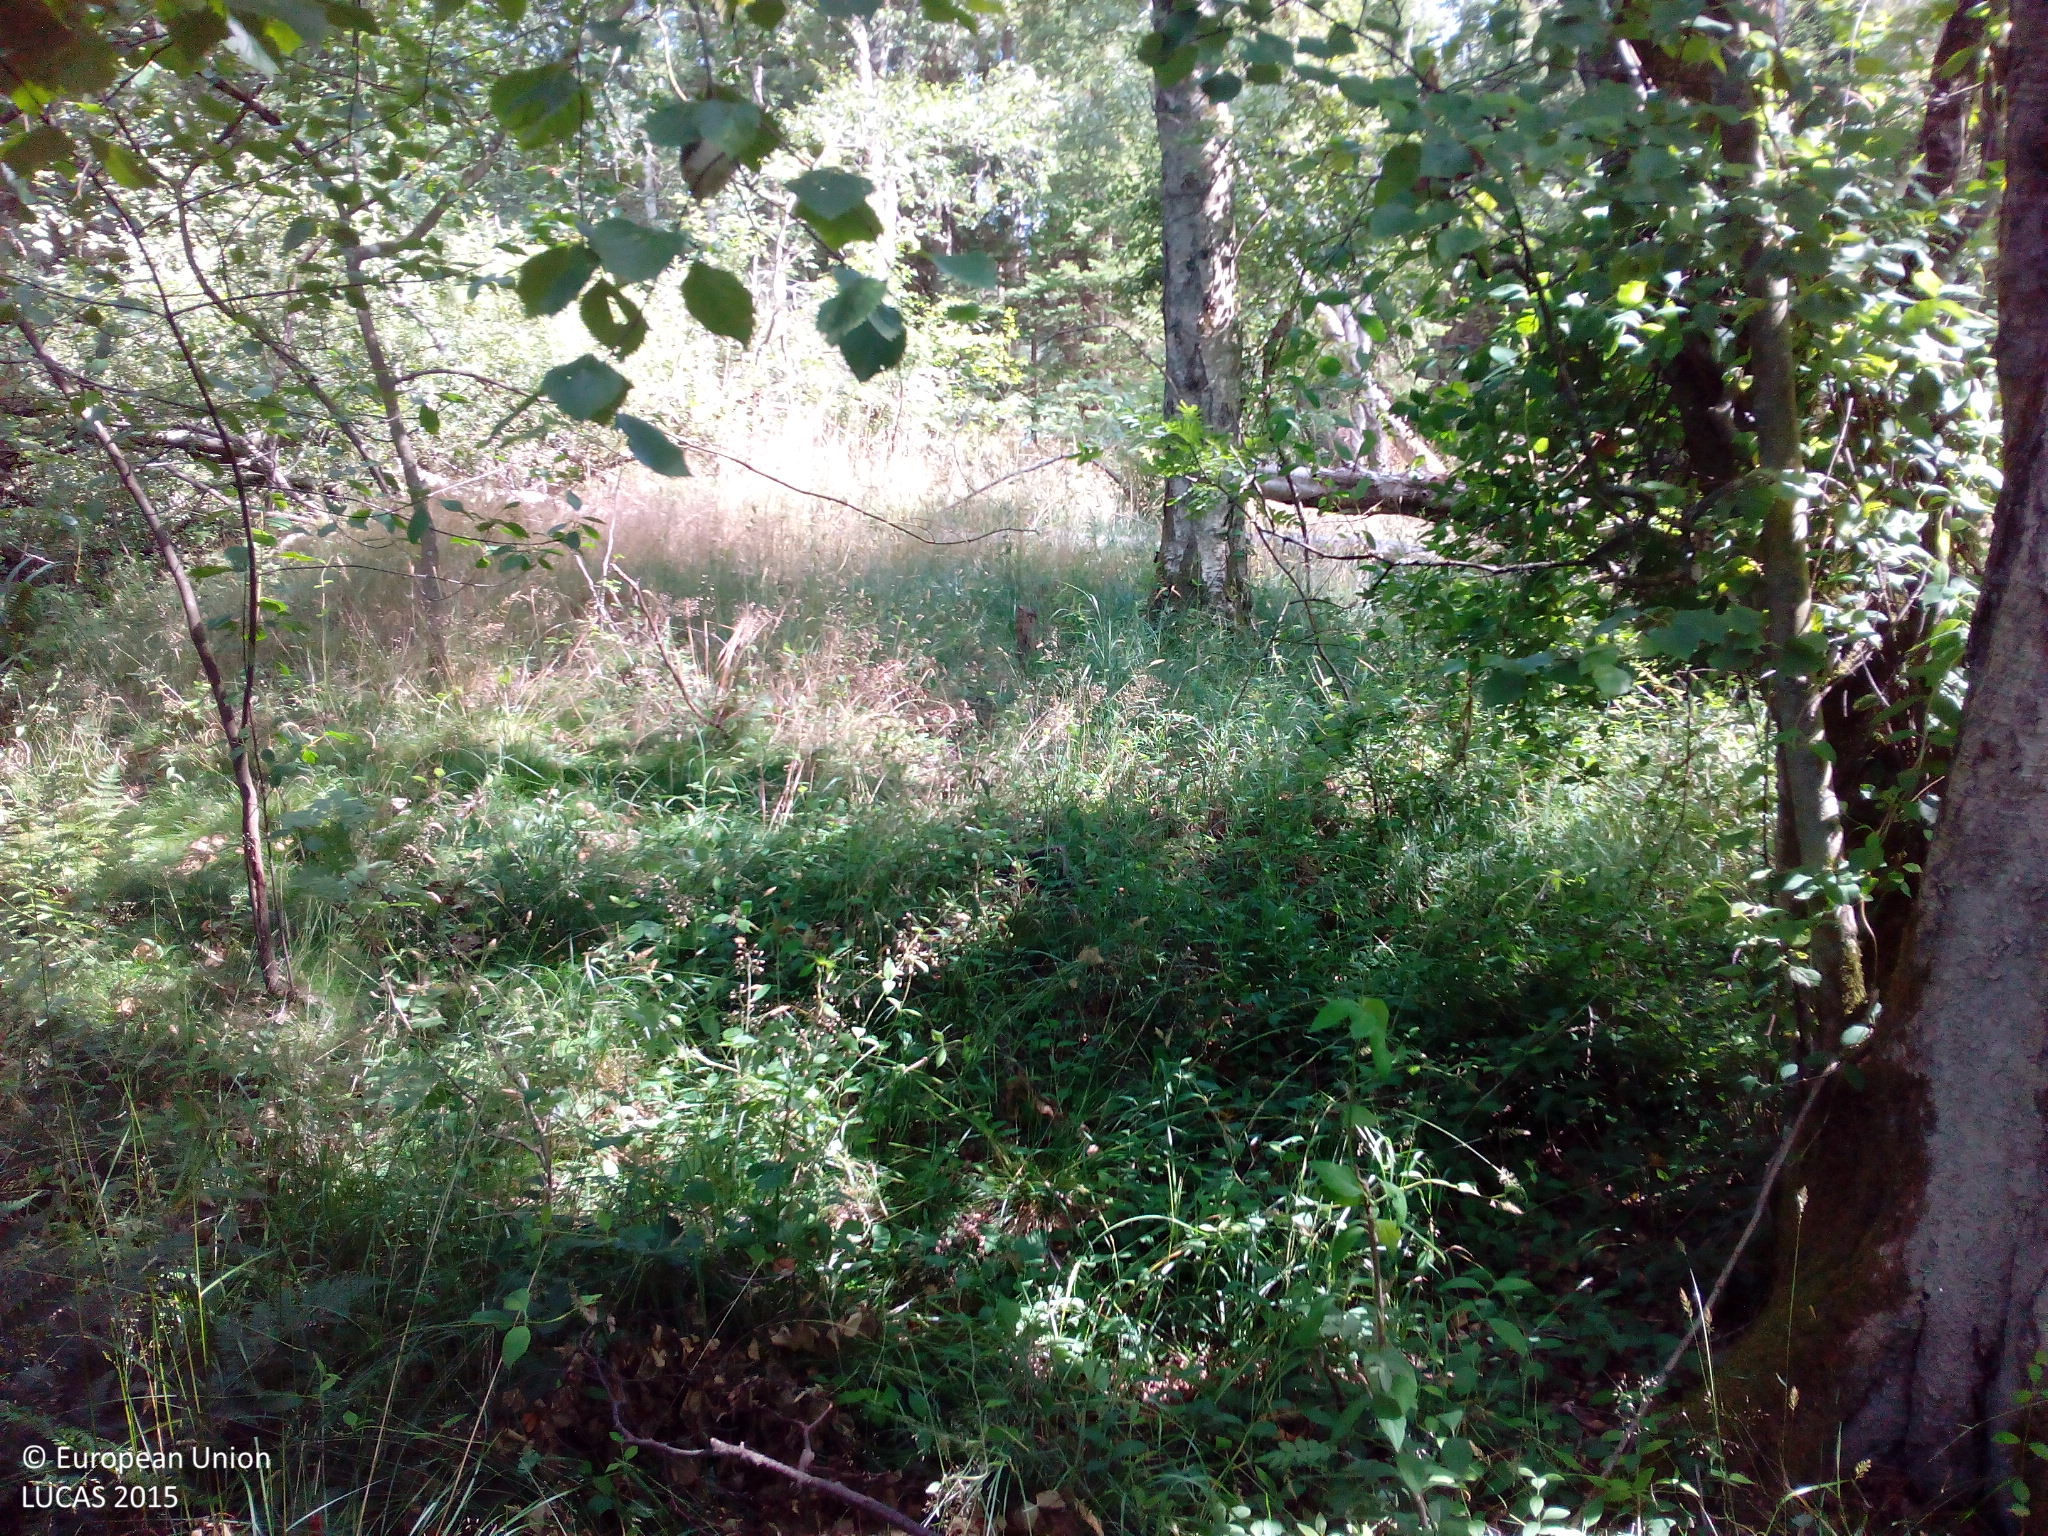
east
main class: Woodland
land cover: Broadleaved woodland
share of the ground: > 75 %
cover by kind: broadleaved forest trees 60 %, herbaceous plants 30 %, shrubs 10 %
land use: Semi-natural and natural areas not in use
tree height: < 5 m
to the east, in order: Broadleaved woodland; Tracks; Broadleaved woodland; Grassland without tree/shrub cover; Artificial constructions in urban areas; Ditches and canals; Grass margins; Tracks; Broadleaved woodland
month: July
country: DK
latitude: 56.0093
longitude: 12.0670
